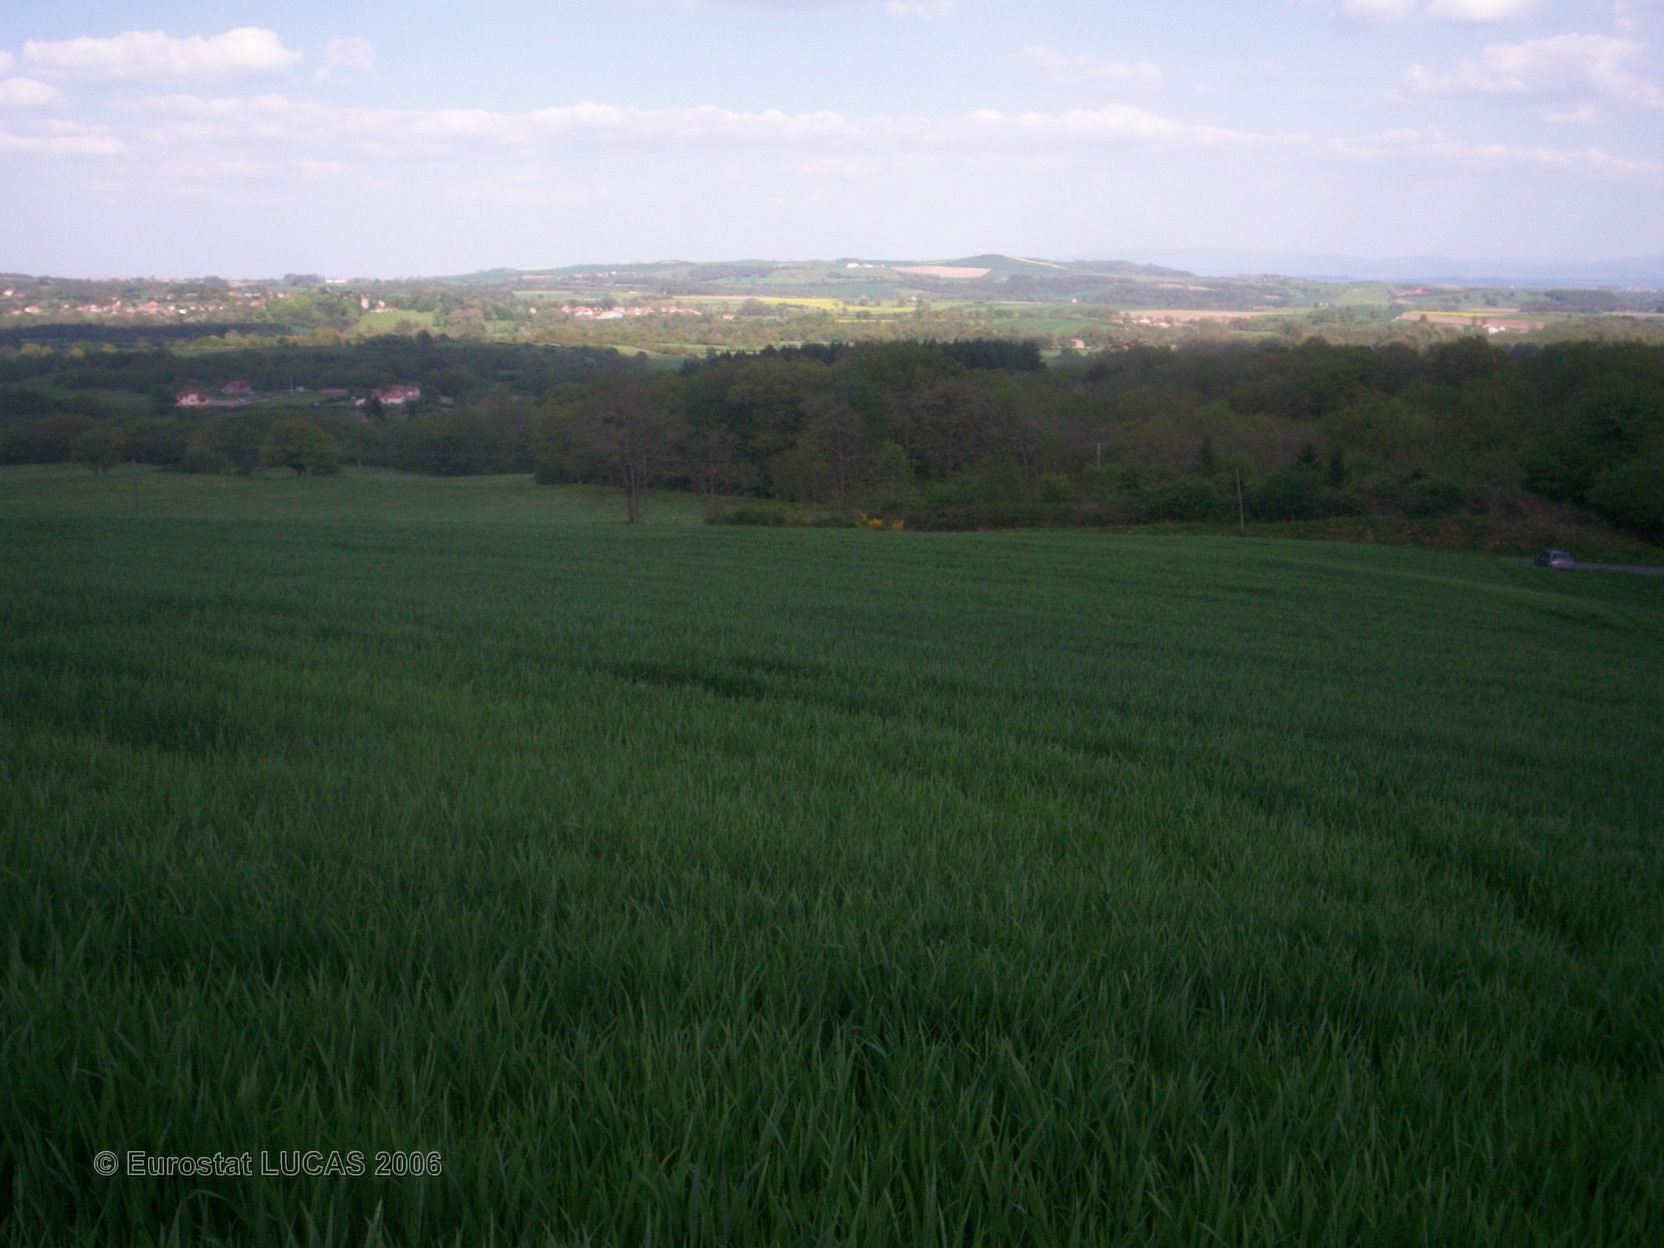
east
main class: Cropland
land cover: Common wheat
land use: Agriculture (excluding fallow land and kitchen gardens)
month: May
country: FR
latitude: 46.0174
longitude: 3.0627
